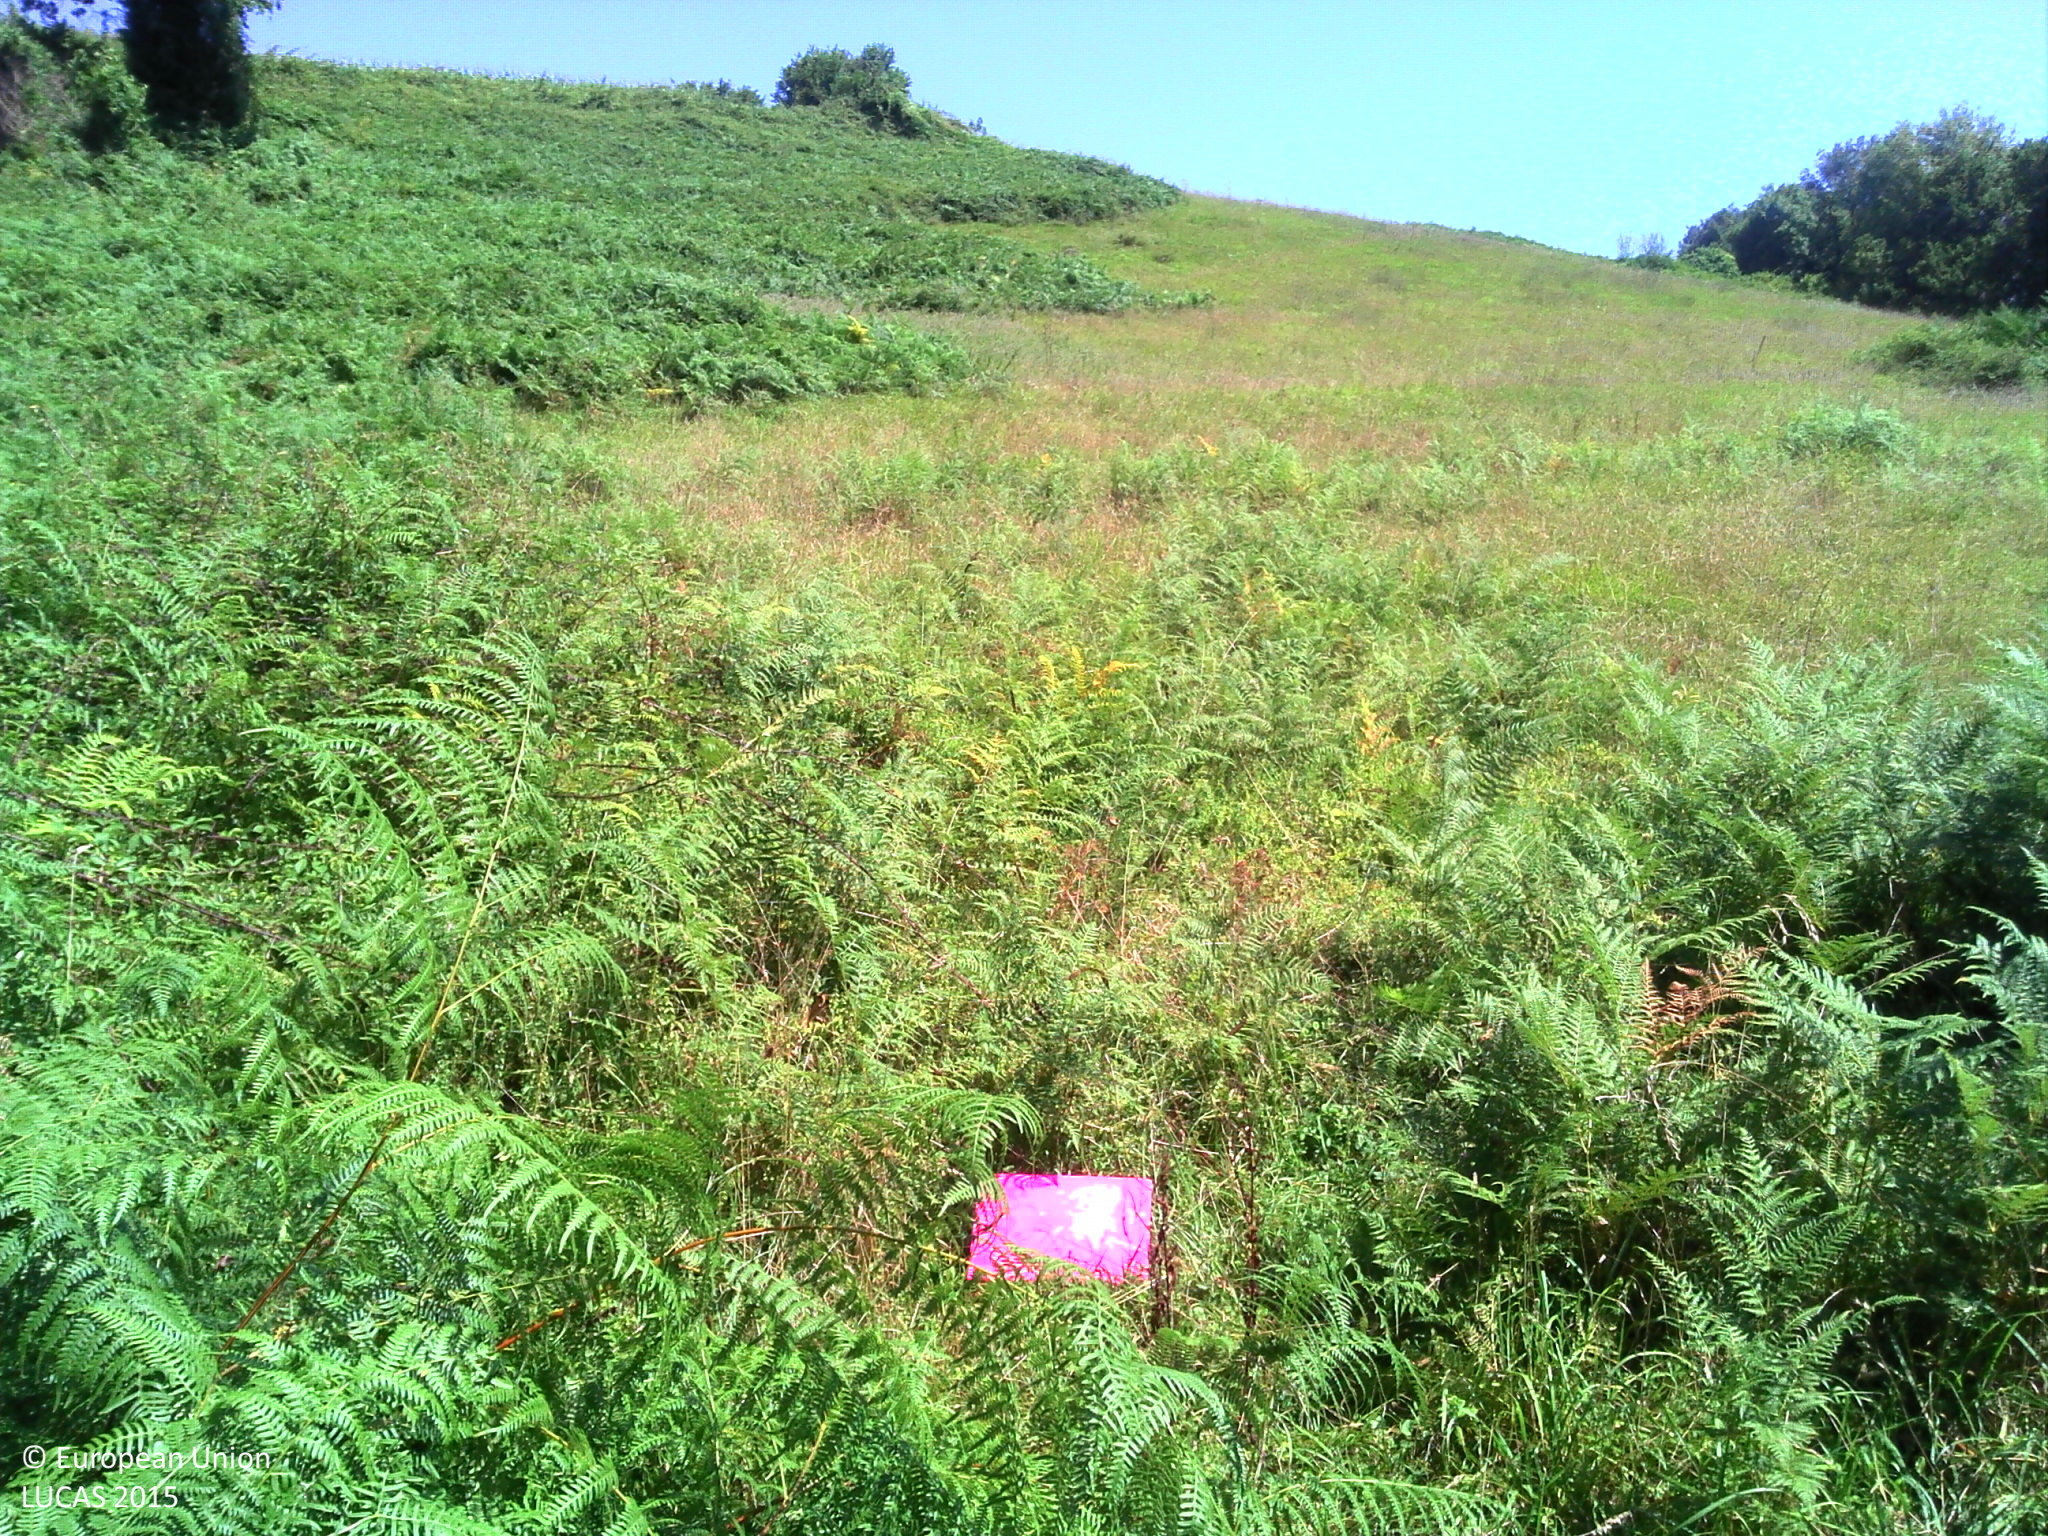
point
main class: Grassland
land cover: Spontaneously vegetated surfaces
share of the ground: > 75 %
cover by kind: herbaceous plants 95 %, shrubs 5 %
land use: Agriculture (excluding fallow land and kitchen gardens)
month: August
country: FR
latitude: 43.4058
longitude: -1.1152
